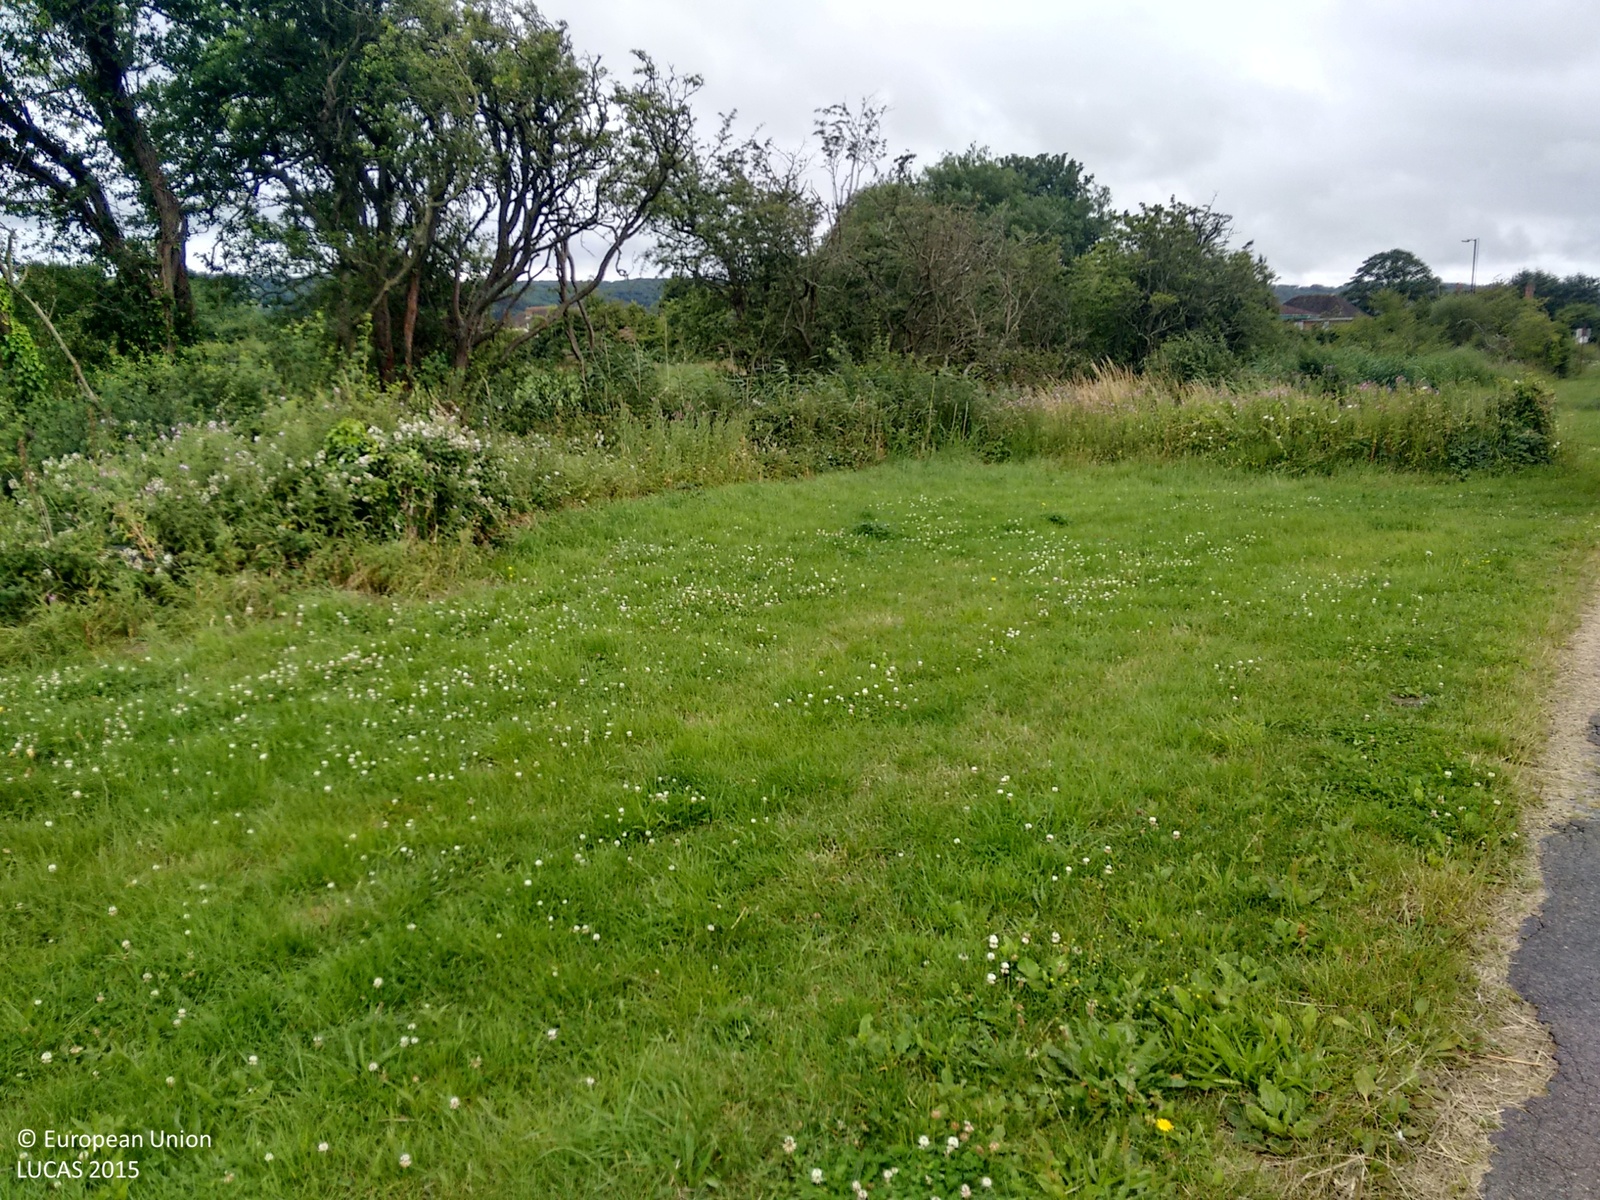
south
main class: Grassland
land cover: Grassland without tree/shrub cover
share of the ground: > 75 %
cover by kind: herbaceous plants 100 %
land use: Semi-natural and natural areas not in use
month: July
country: GB
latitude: 51.3396
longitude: -2.9214
